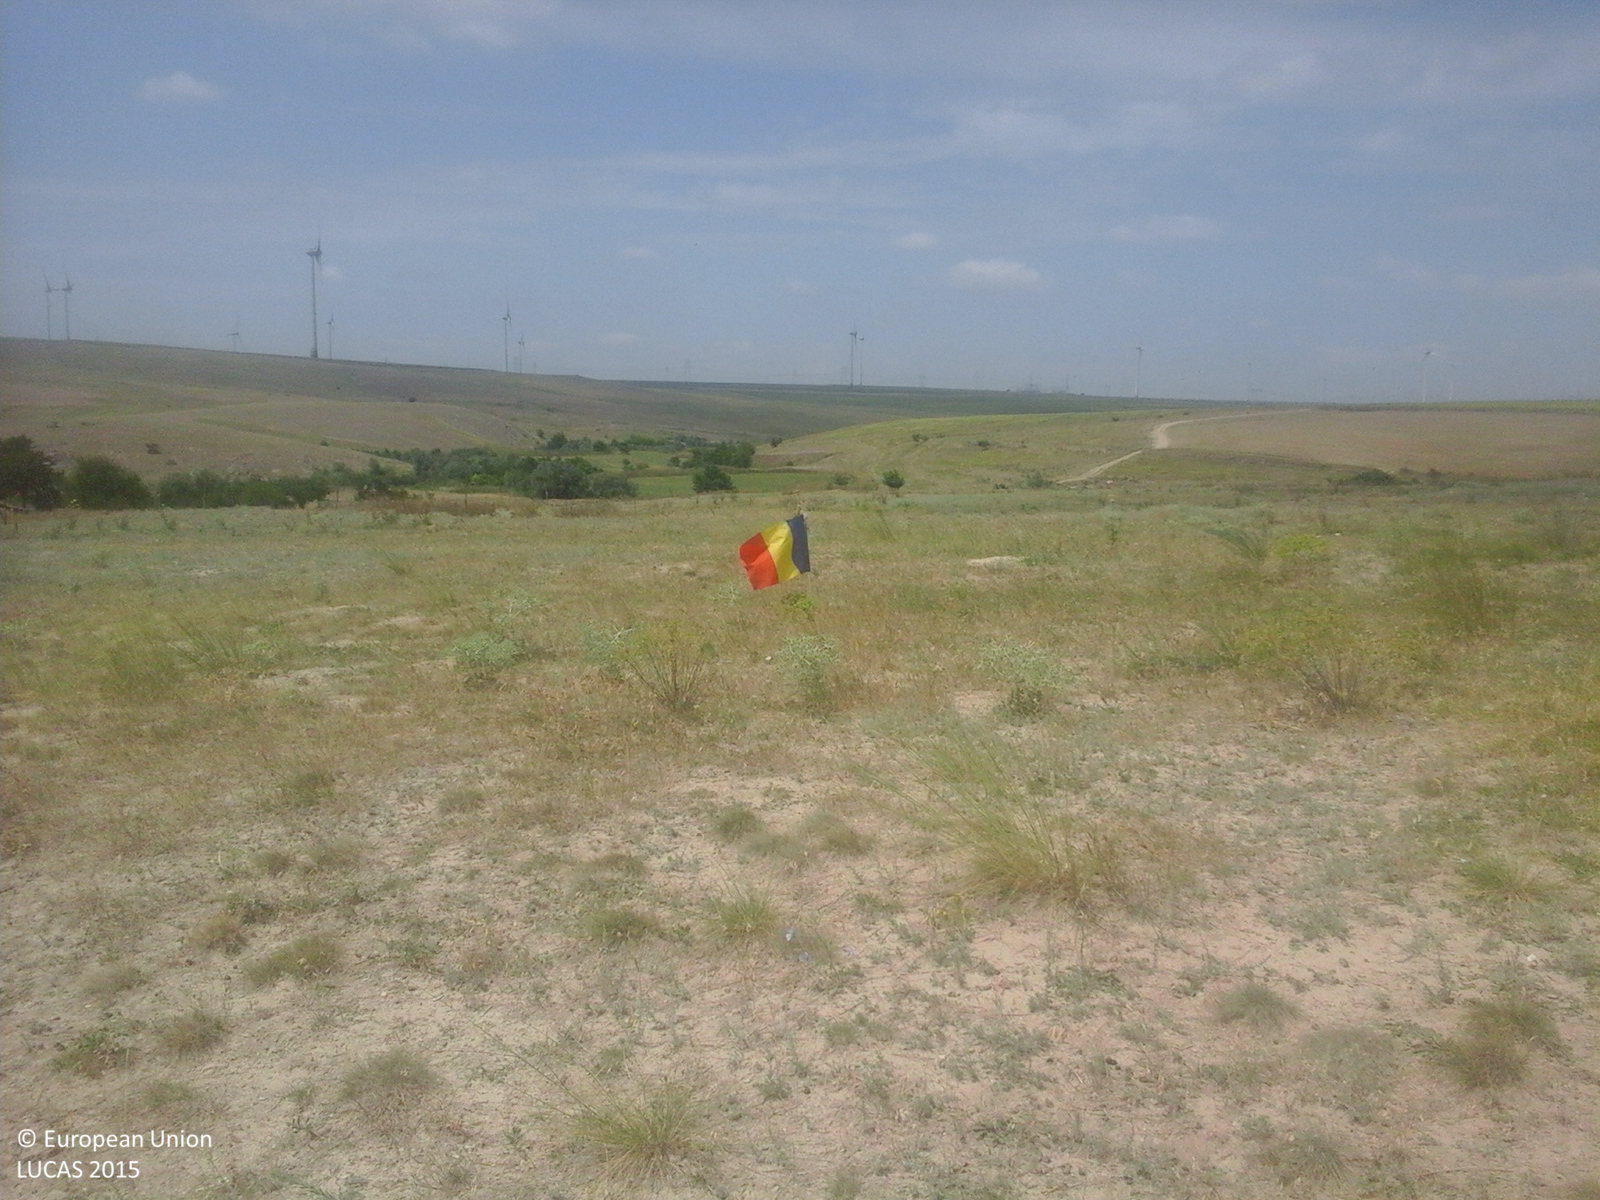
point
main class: Grassland
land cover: Grassland without tree/shrub cover
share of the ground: 50 - 75 %
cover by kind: herbaceous plants 100 %
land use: Agriculture (excluding fallow land and kitchen gardens)
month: August
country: RO
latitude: 44.7770
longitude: 28.2786
